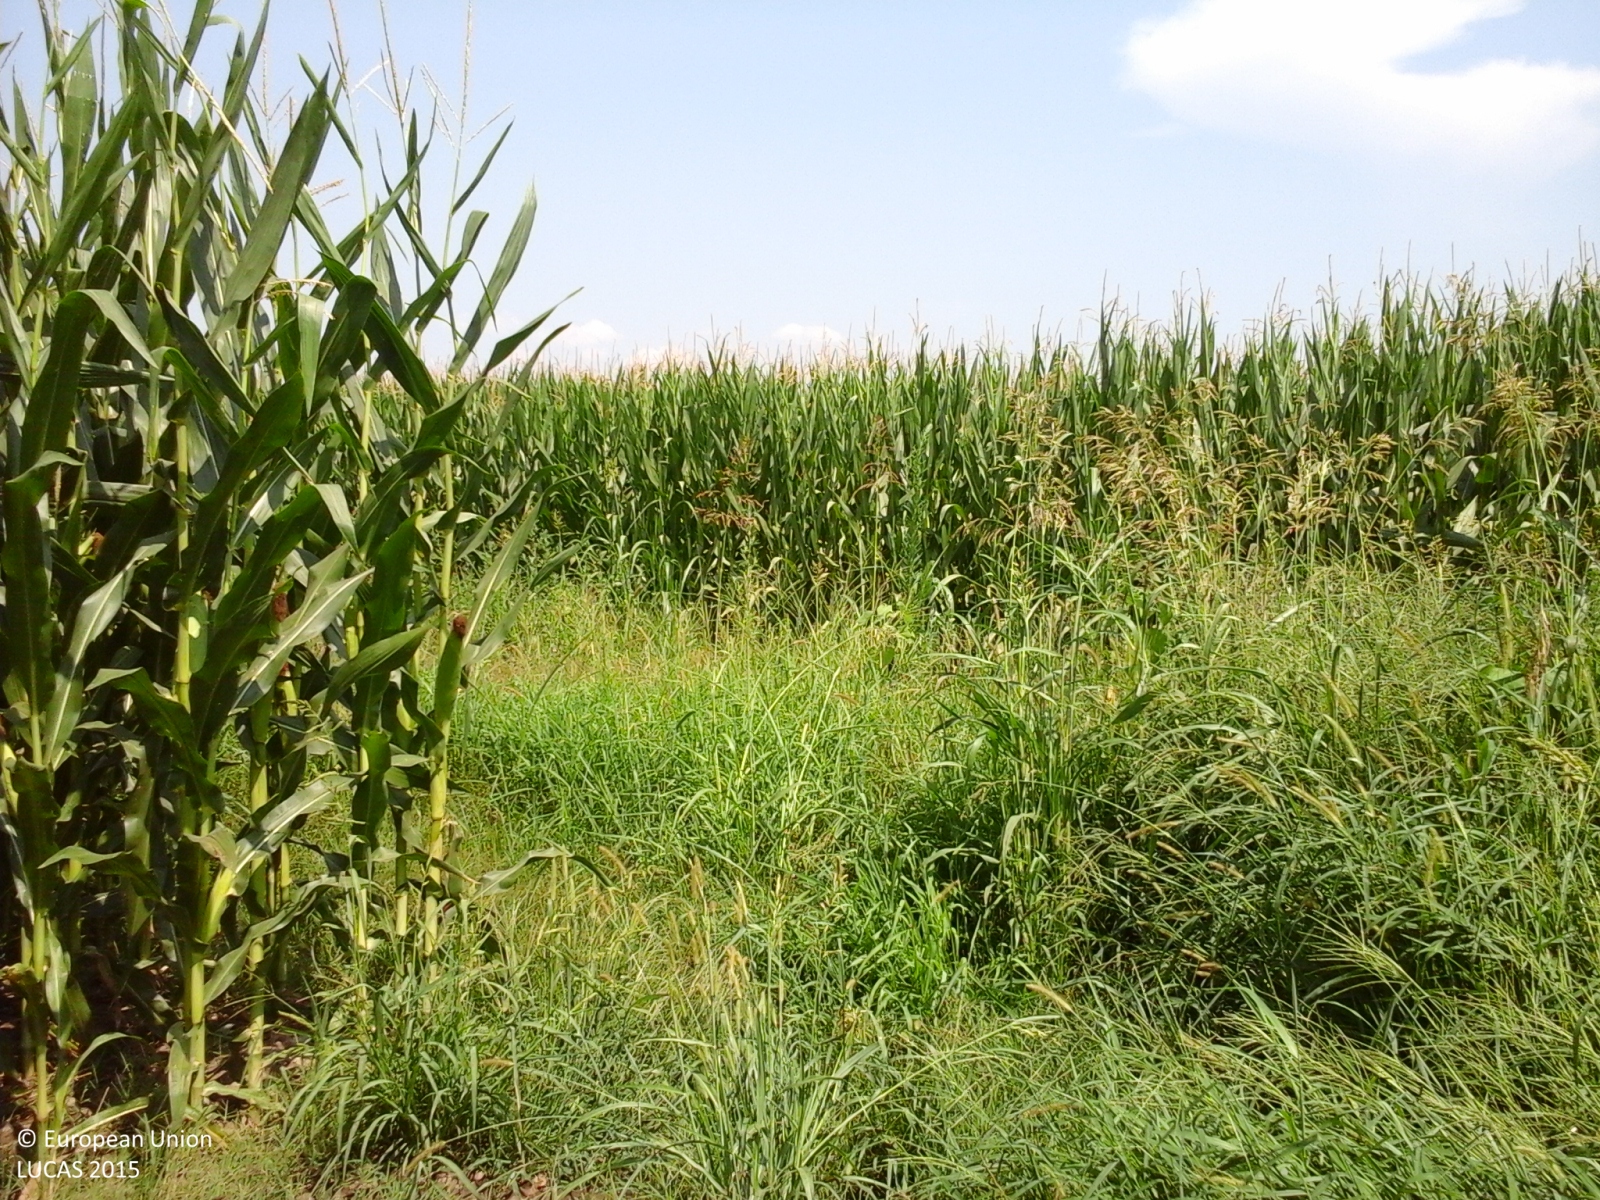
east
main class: Cropland
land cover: Maize
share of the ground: > 75 %
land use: Agriculture (excluding fallow land and kitchen gardens)
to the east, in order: Maize; Ditches and canals; Maize; Ditches and canals; Maize; Ditches and canals; Maize
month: July
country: IT
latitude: 44.3963
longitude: 7.6572
